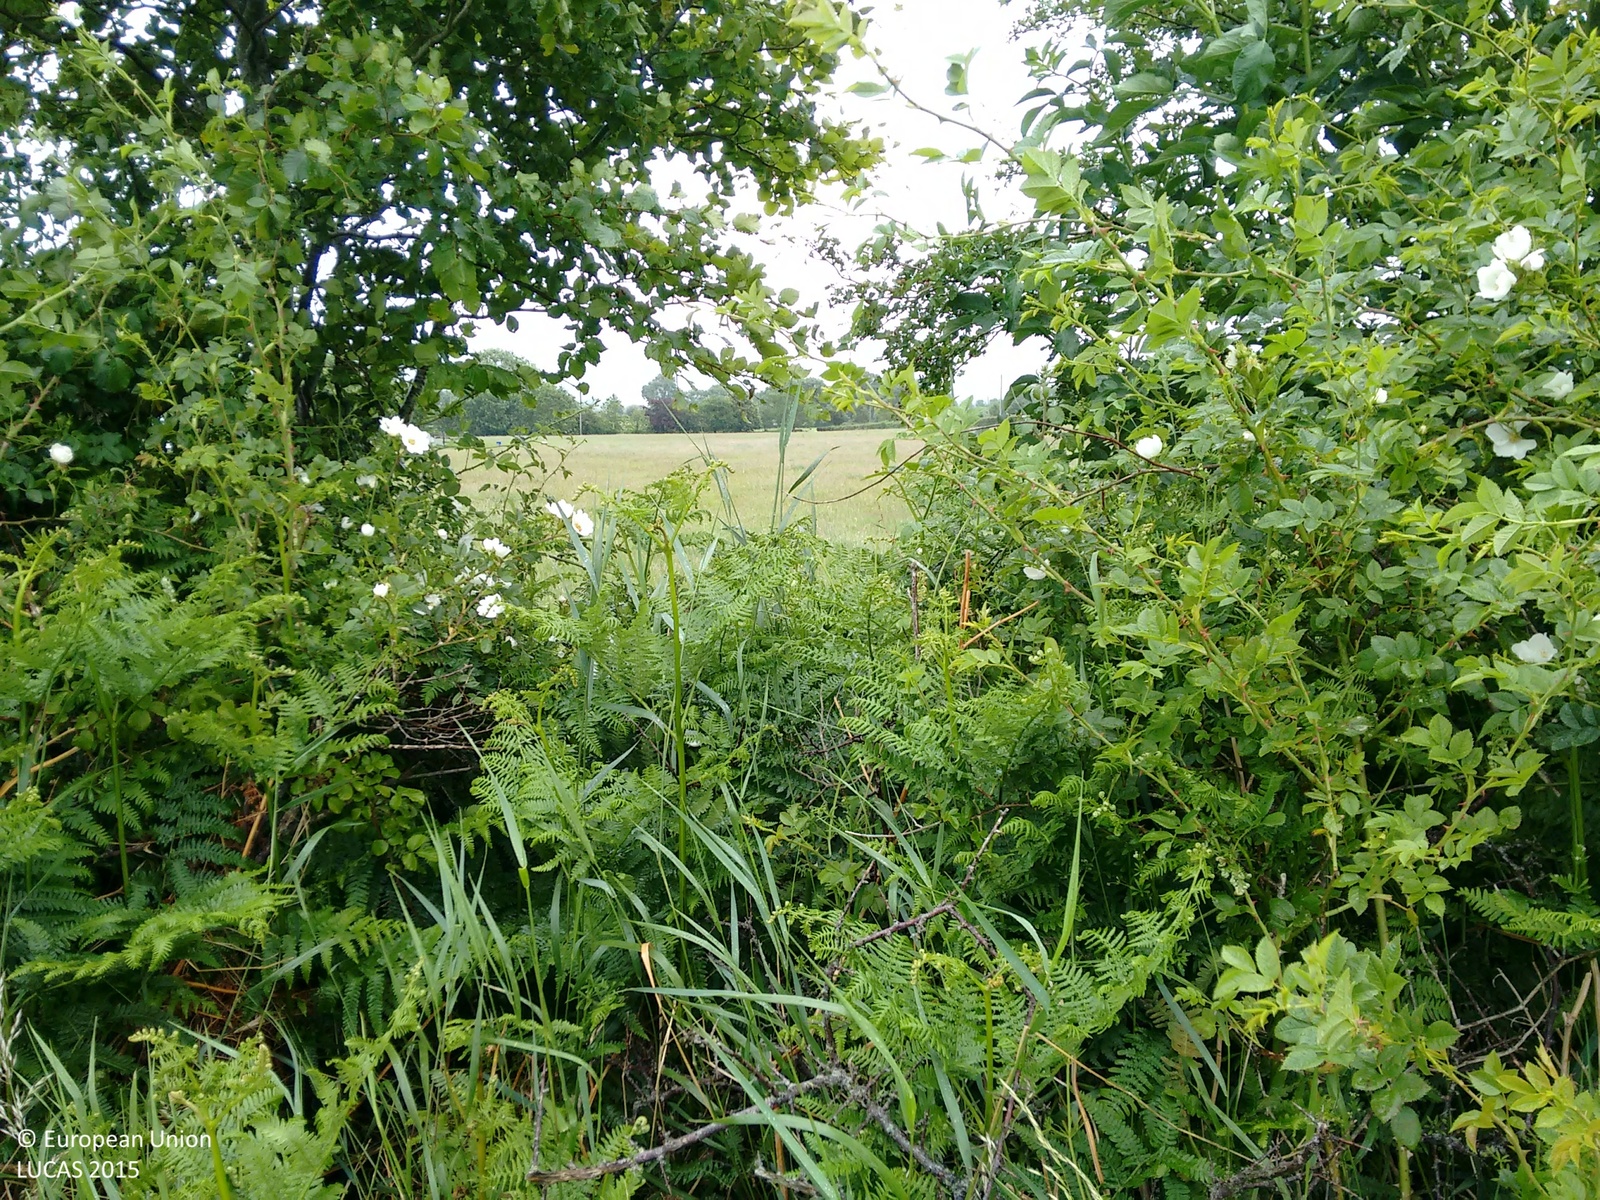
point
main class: Grassland
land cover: Grassland without tree/shrub cover
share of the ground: > 75 %
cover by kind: herbaceous plants 100 %
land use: Agriculture (excluding fallow land and kitchen gardens)
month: June
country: IE
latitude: 52.3741
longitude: -7.4763
